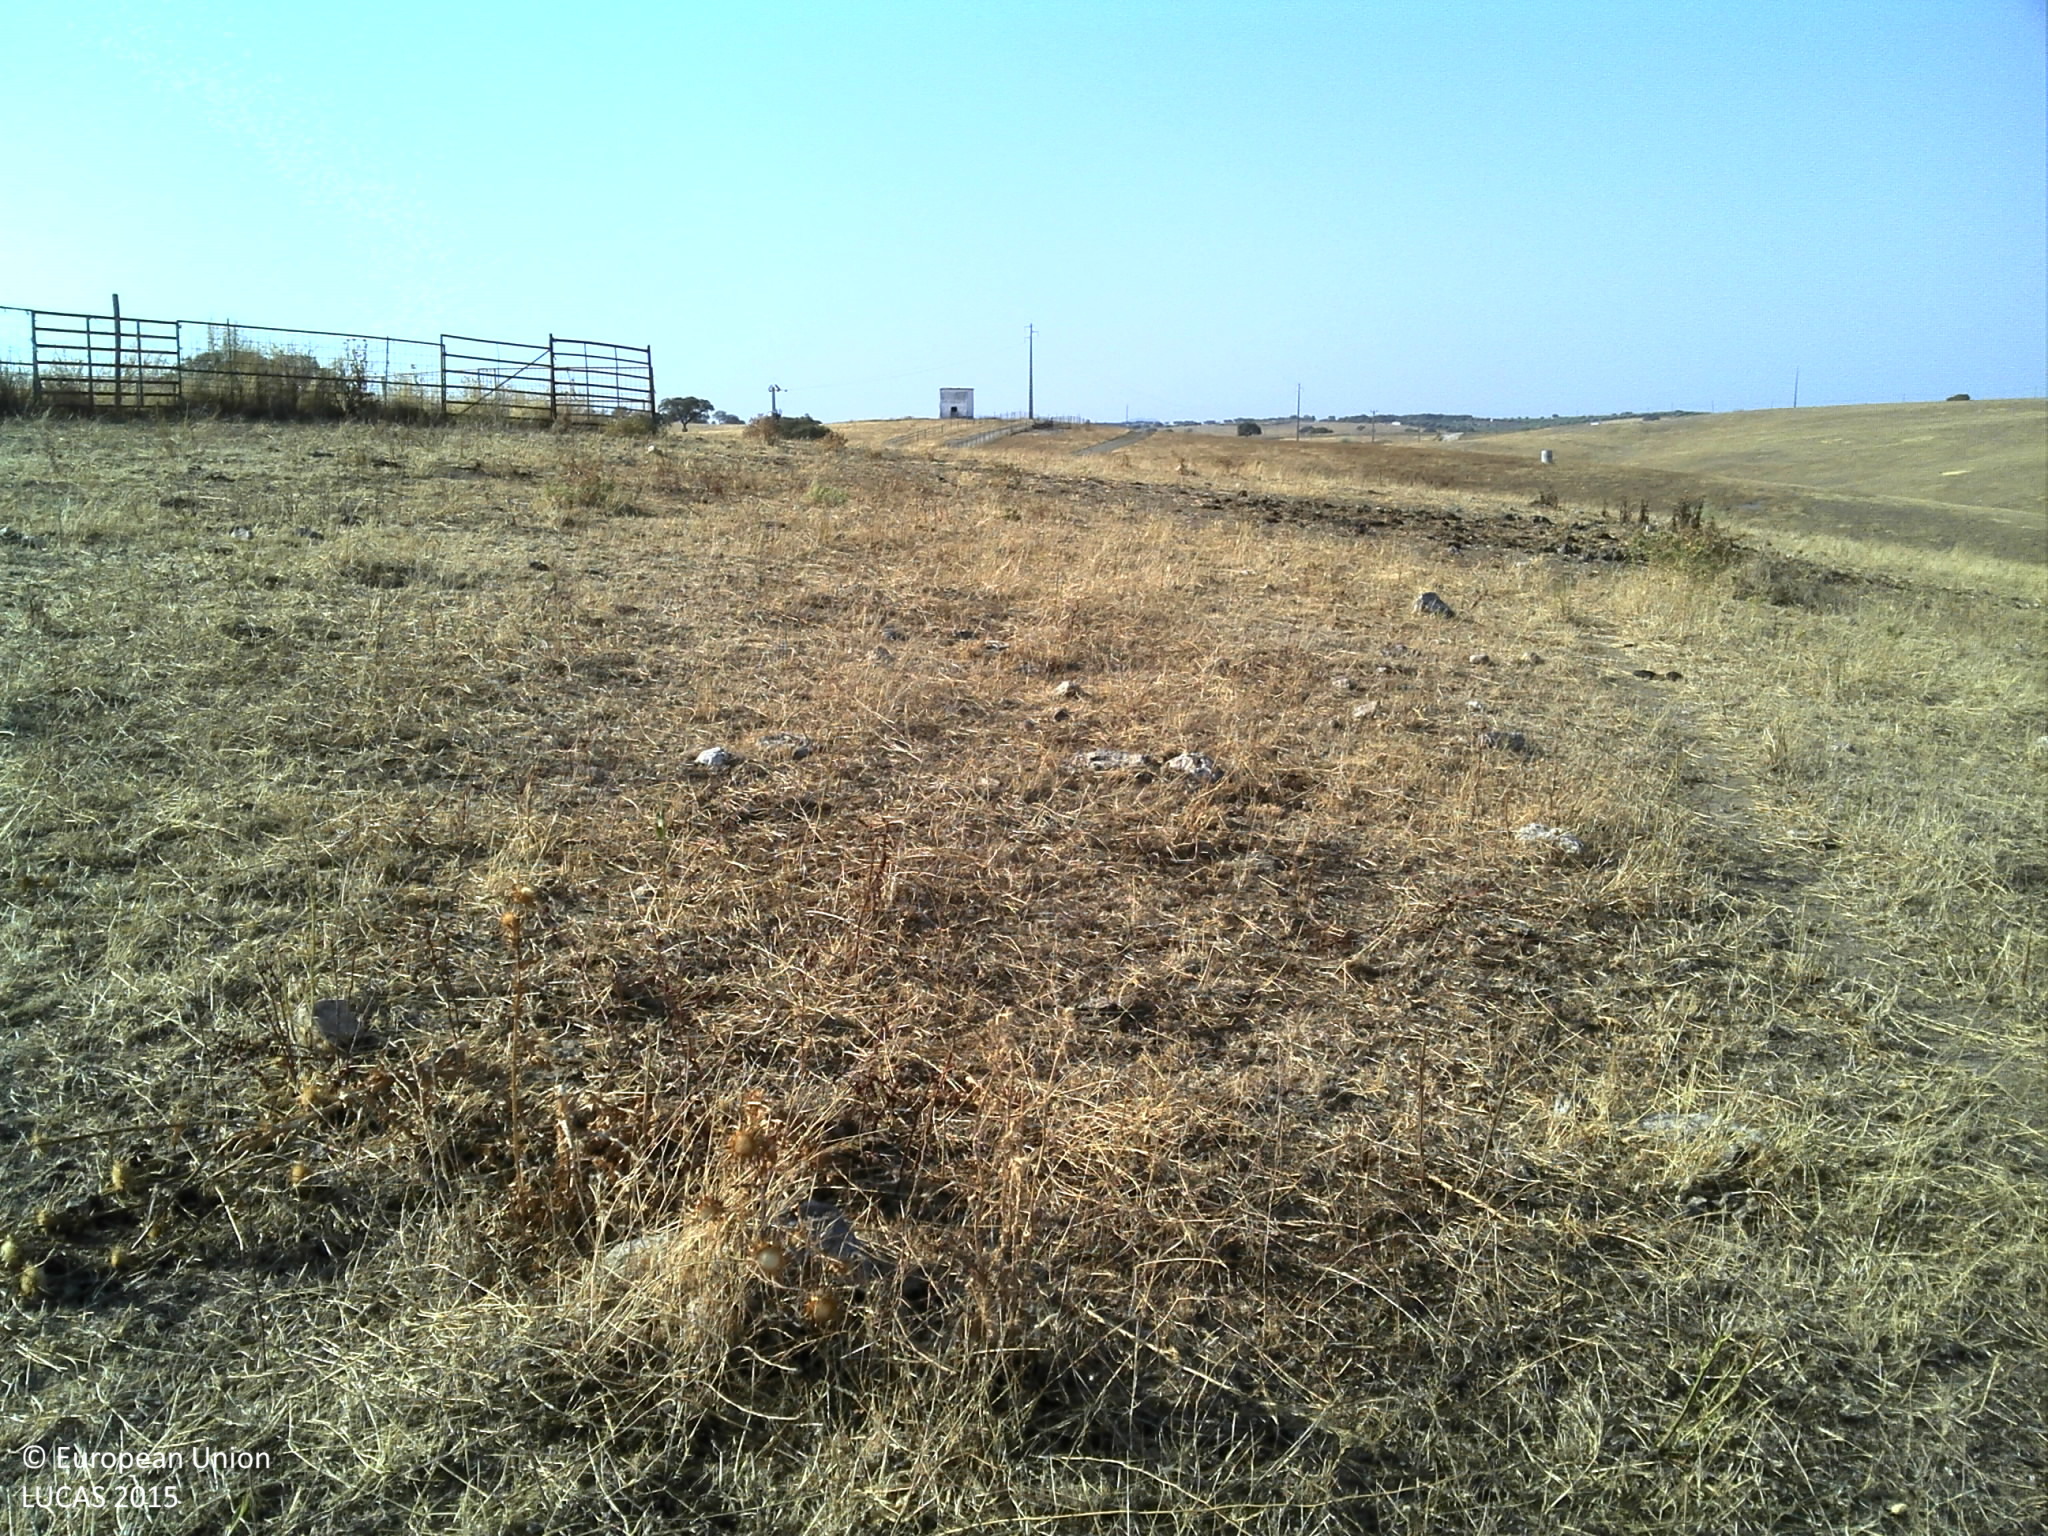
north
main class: Grassland
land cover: Grassland without tree/shrub cover
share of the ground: 10 - 25 %
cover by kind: herbaceous plants 100 %
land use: Agriculture (excluding fallow land and kitchen gardens)
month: June
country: PT
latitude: 38.2593
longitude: -7.3811
